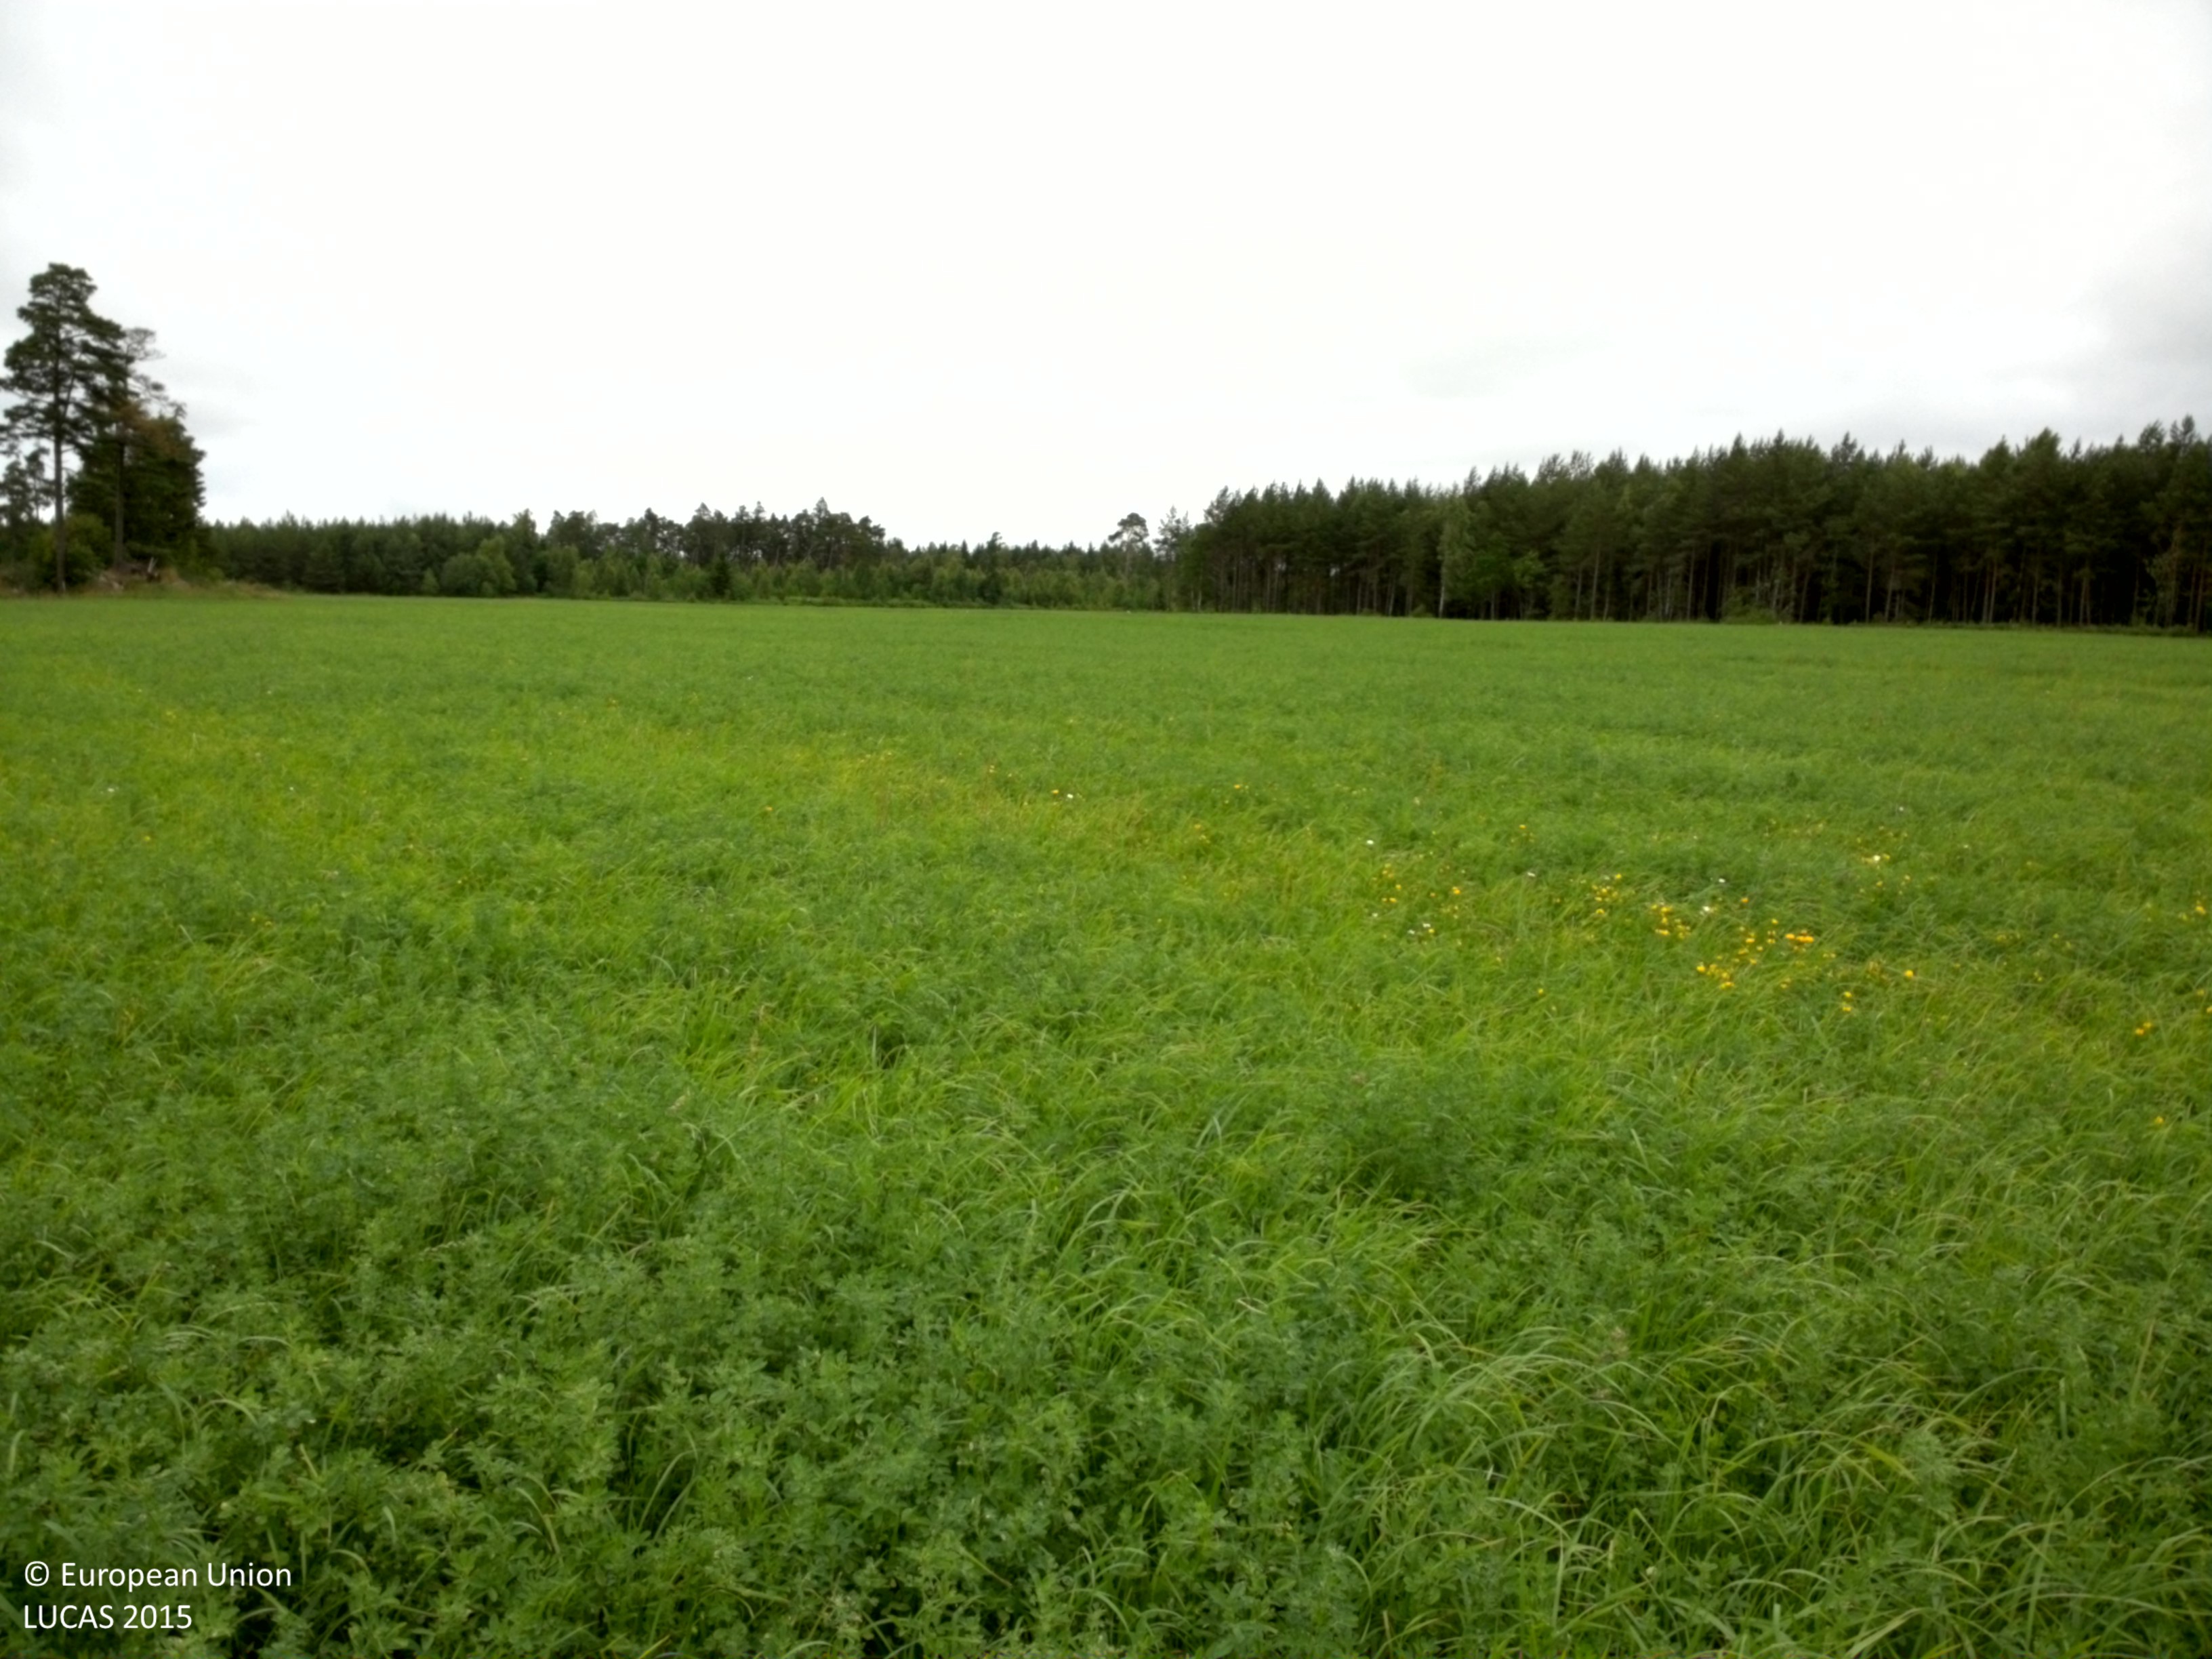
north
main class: Cropland
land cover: Lucerne
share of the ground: > 75 %
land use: Agriculture (excluding fallow land and kitchen gardens)
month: July
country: SE
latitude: 57.4827
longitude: 18.1628
